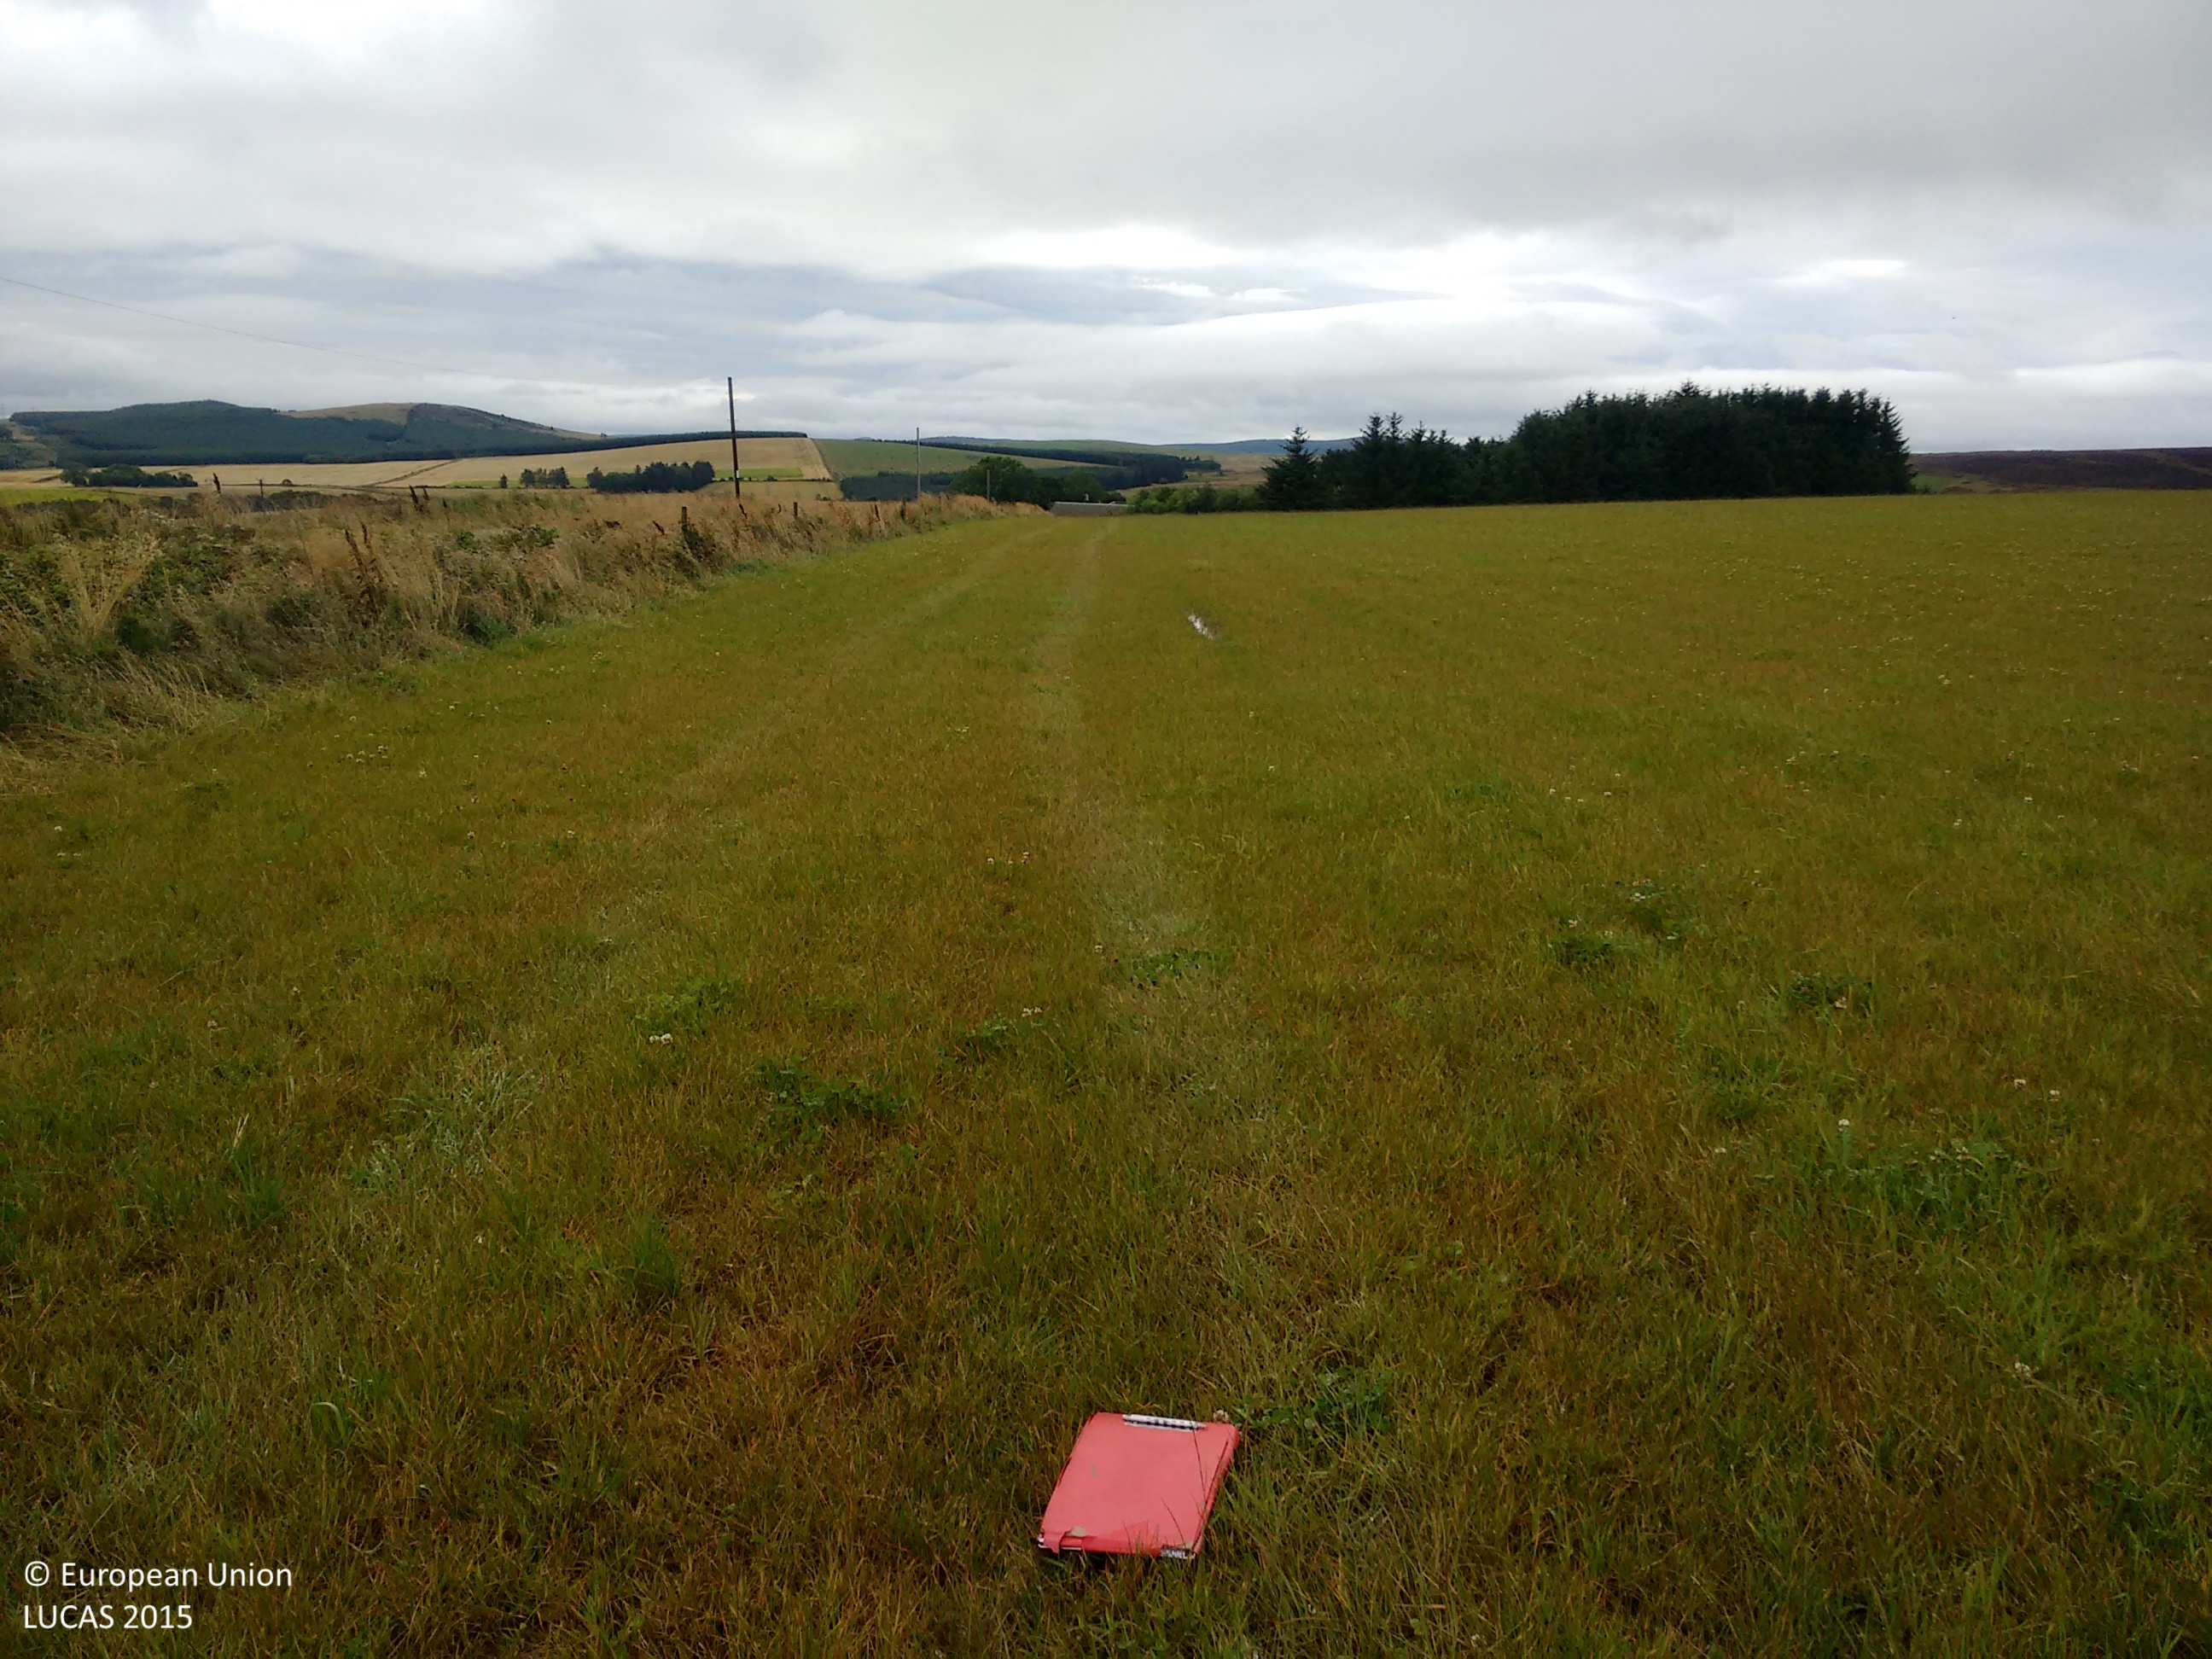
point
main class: Grassland
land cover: Grassland without tree/shrub cover
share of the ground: > 75 %
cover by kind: herbaceous plants 95 %, unconsolidated bare surface 5 %
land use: Agriculture (excluding fallow land and kitchen gardens)
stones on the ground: 10 - 25 %
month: September
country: GB
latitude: 57.5006
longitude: -2.9259
